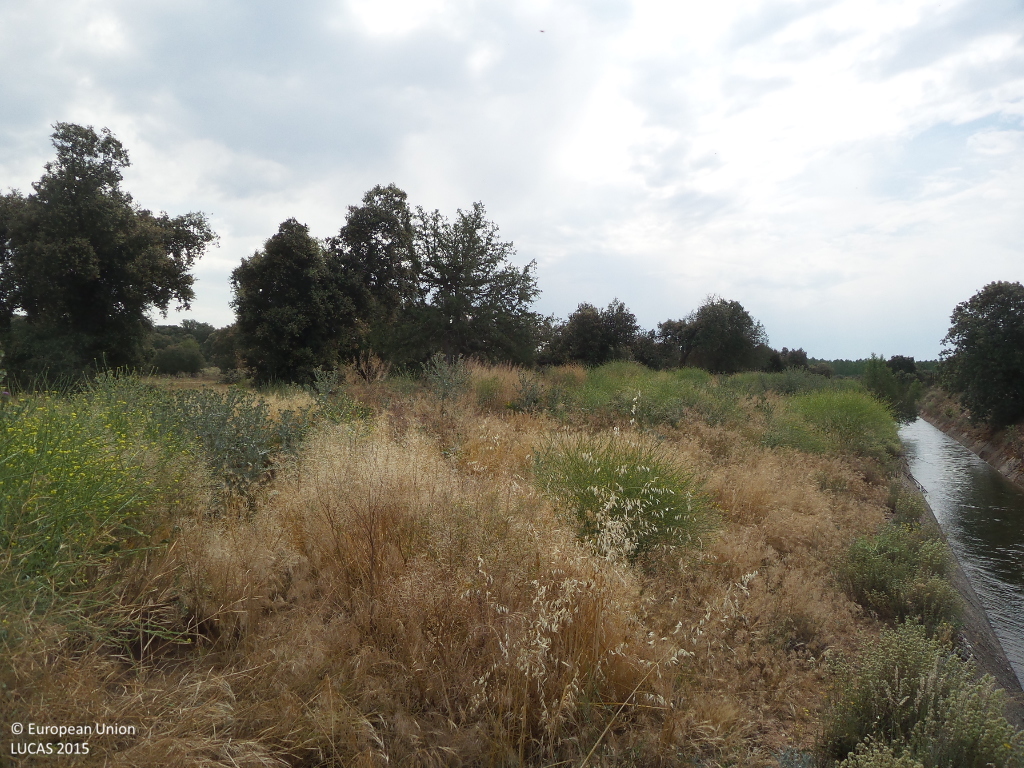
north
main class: Woodland
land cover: Broadleaved woodland
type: broadleaved evergreen forest
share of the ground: 10 - 25 %
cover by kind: herbaceous plants 40 %, shrubs 25 %, broadleaved forest trees 20 %, unconsolidated bare surface 10 %, coniferous forest trees 5 %
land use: Forestry
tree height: > 5 m
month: June
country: ES
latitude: 41.5258
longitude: -3.0938
